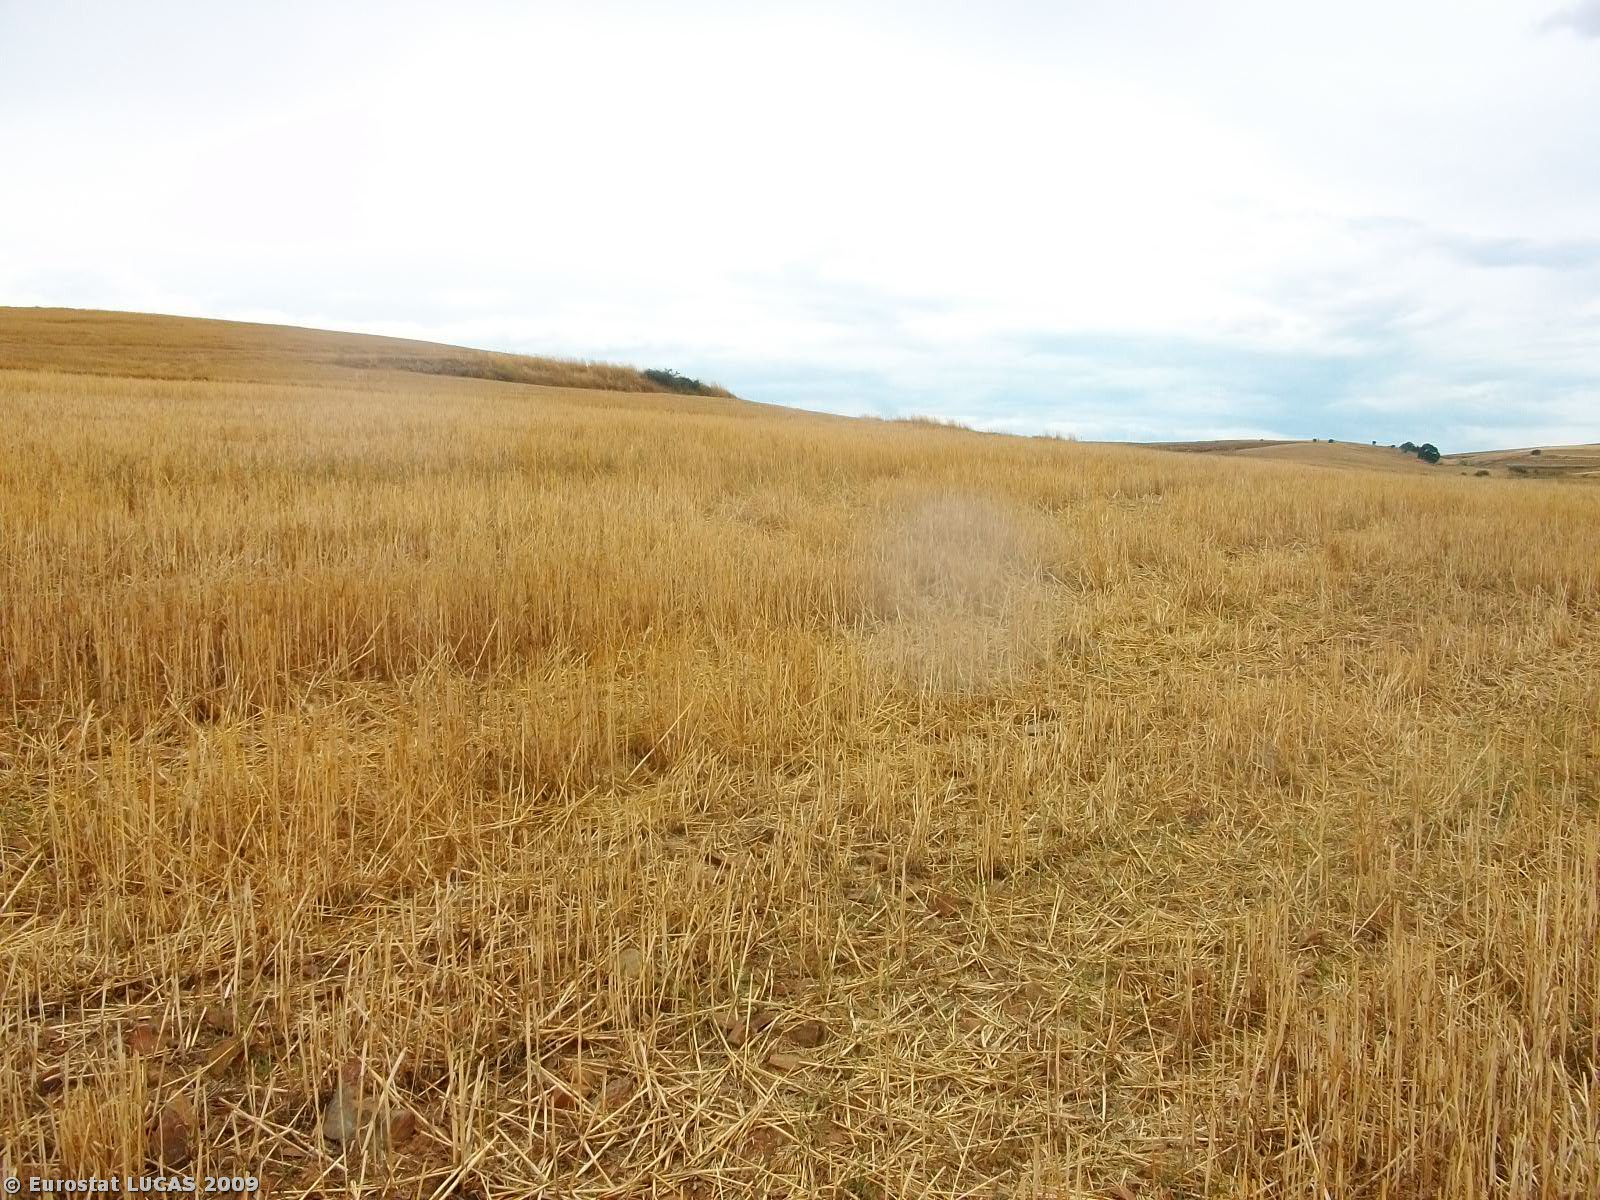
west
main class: Cropland
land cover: Durum wheat
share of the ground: > 75 %
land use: Agriculture (excluding fallow land and kitchen gardens)
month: June
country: GR
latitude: 40.9340
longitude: 22.7280
